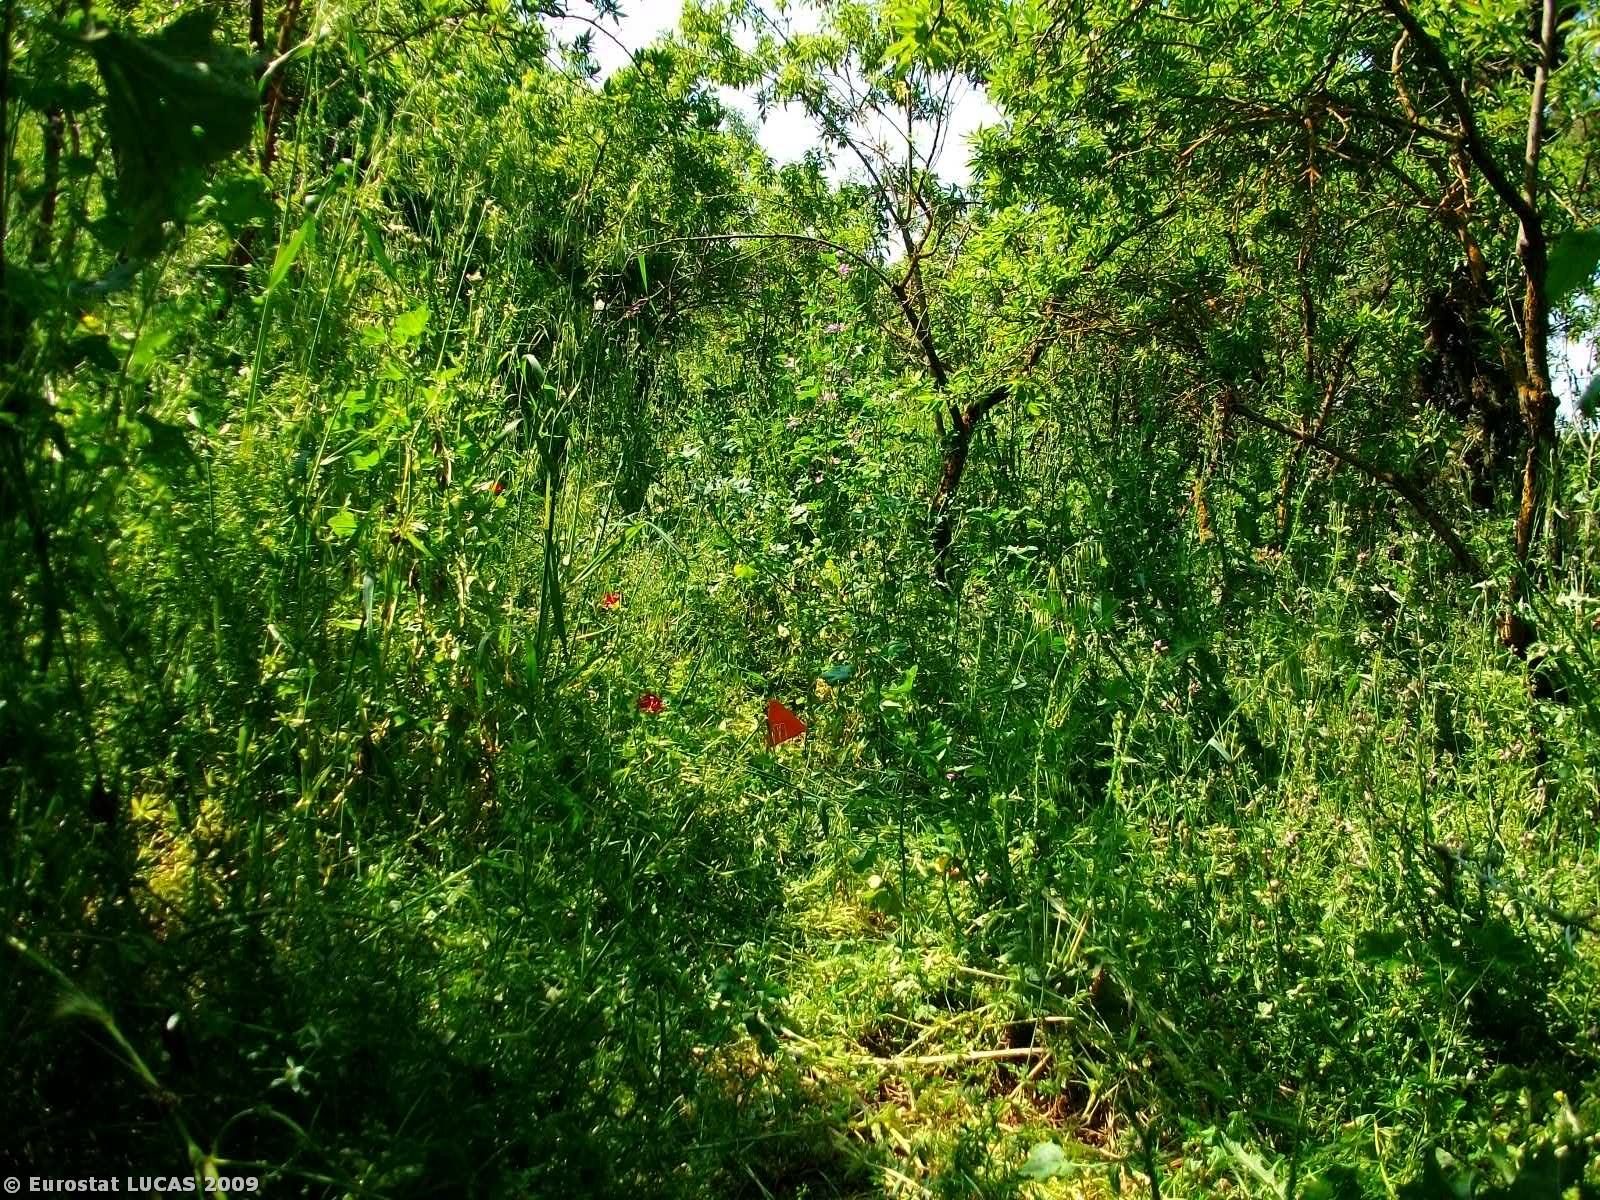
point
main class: Cropland
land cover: Nuts trees
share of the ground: 50 - 75 %
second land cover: Grassland with sparse tree/shrub cover
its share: > 75 %
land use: Agriculture (excluding fallow land and kitchen gardens)
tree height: > 5 m
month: May
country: GR
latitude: 39.3772
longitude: 22.7475
